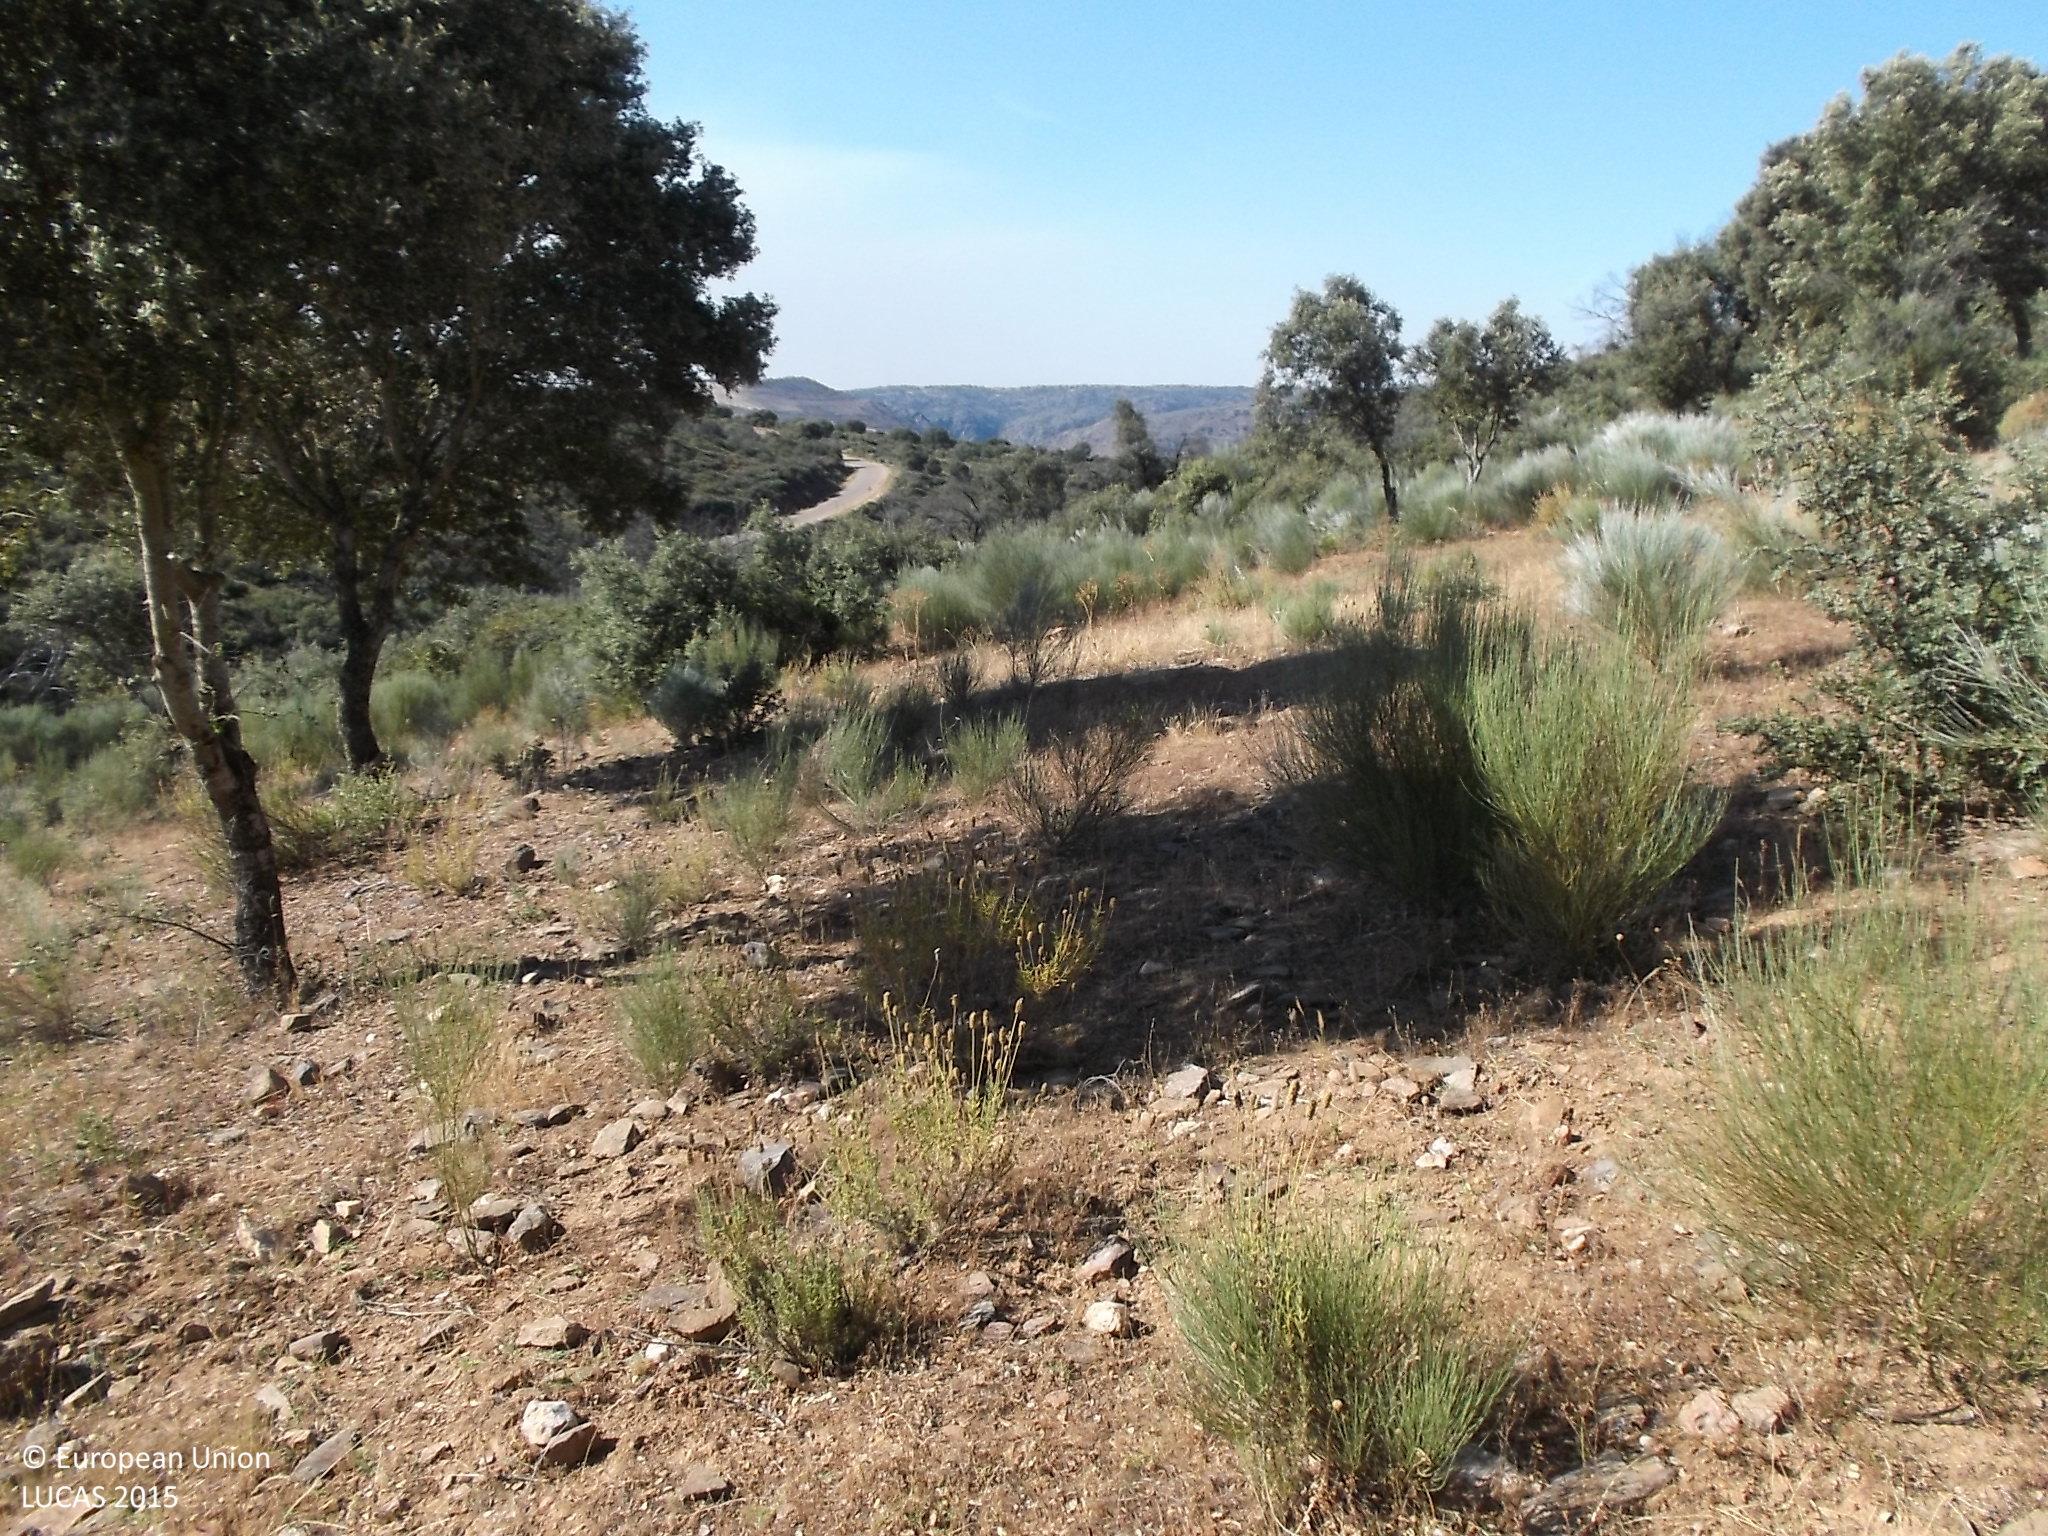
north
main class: Woodland
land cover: Broadleaved woodland
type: broadleaved evergreen forest
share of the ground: 25 - 50 %
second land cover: Shrubland without tree cover
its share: 25 - 50 %
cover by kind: herbaceous plants 40 %, broadleaved forest trees 30 %, shrubs 30 %
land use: Forestry
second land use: Agriculture (excluding fallow land and kitchen gardens)
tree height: < 5 m
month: July
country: ES
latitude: 40.8324
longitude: -6.8083
